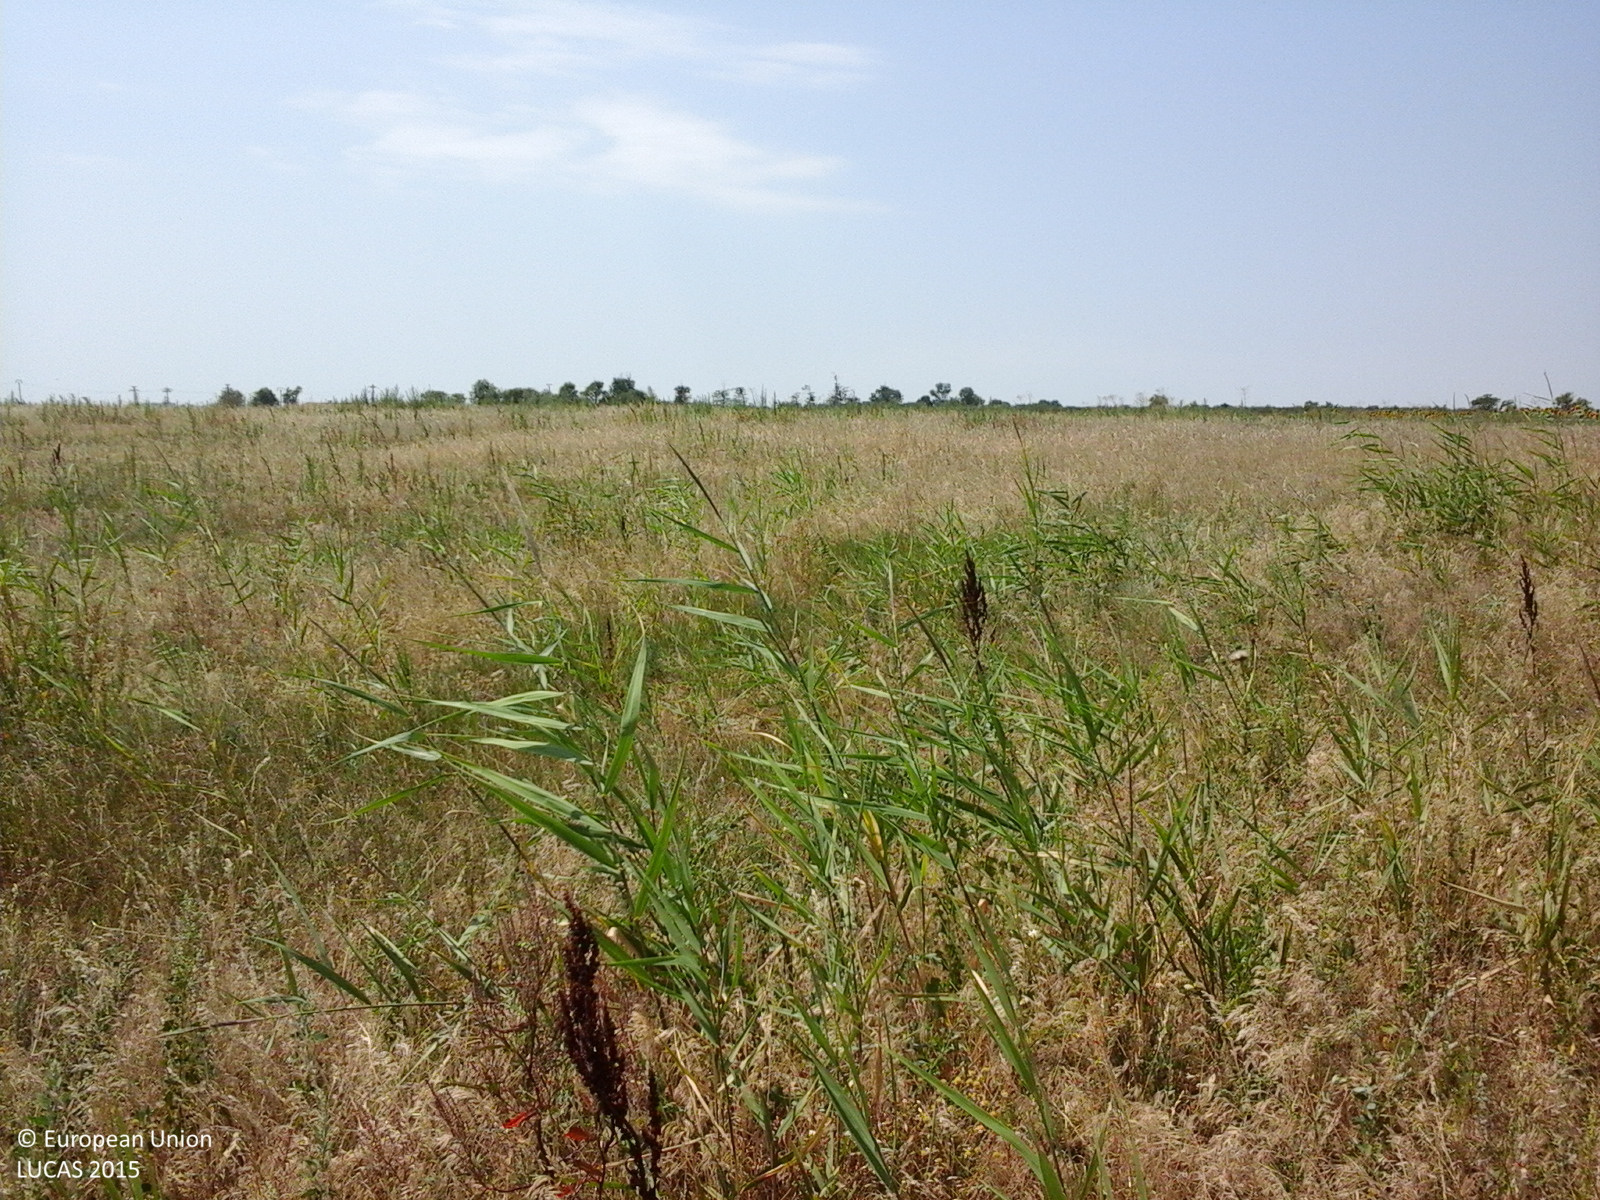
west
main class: Grassland
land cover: Spontaneously vegetated surfaces
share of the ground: > 75 %
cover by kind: herbaceous plants 100 %
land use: Fallow land
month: July
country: RO
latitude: 44.9693
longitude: 27.2709
